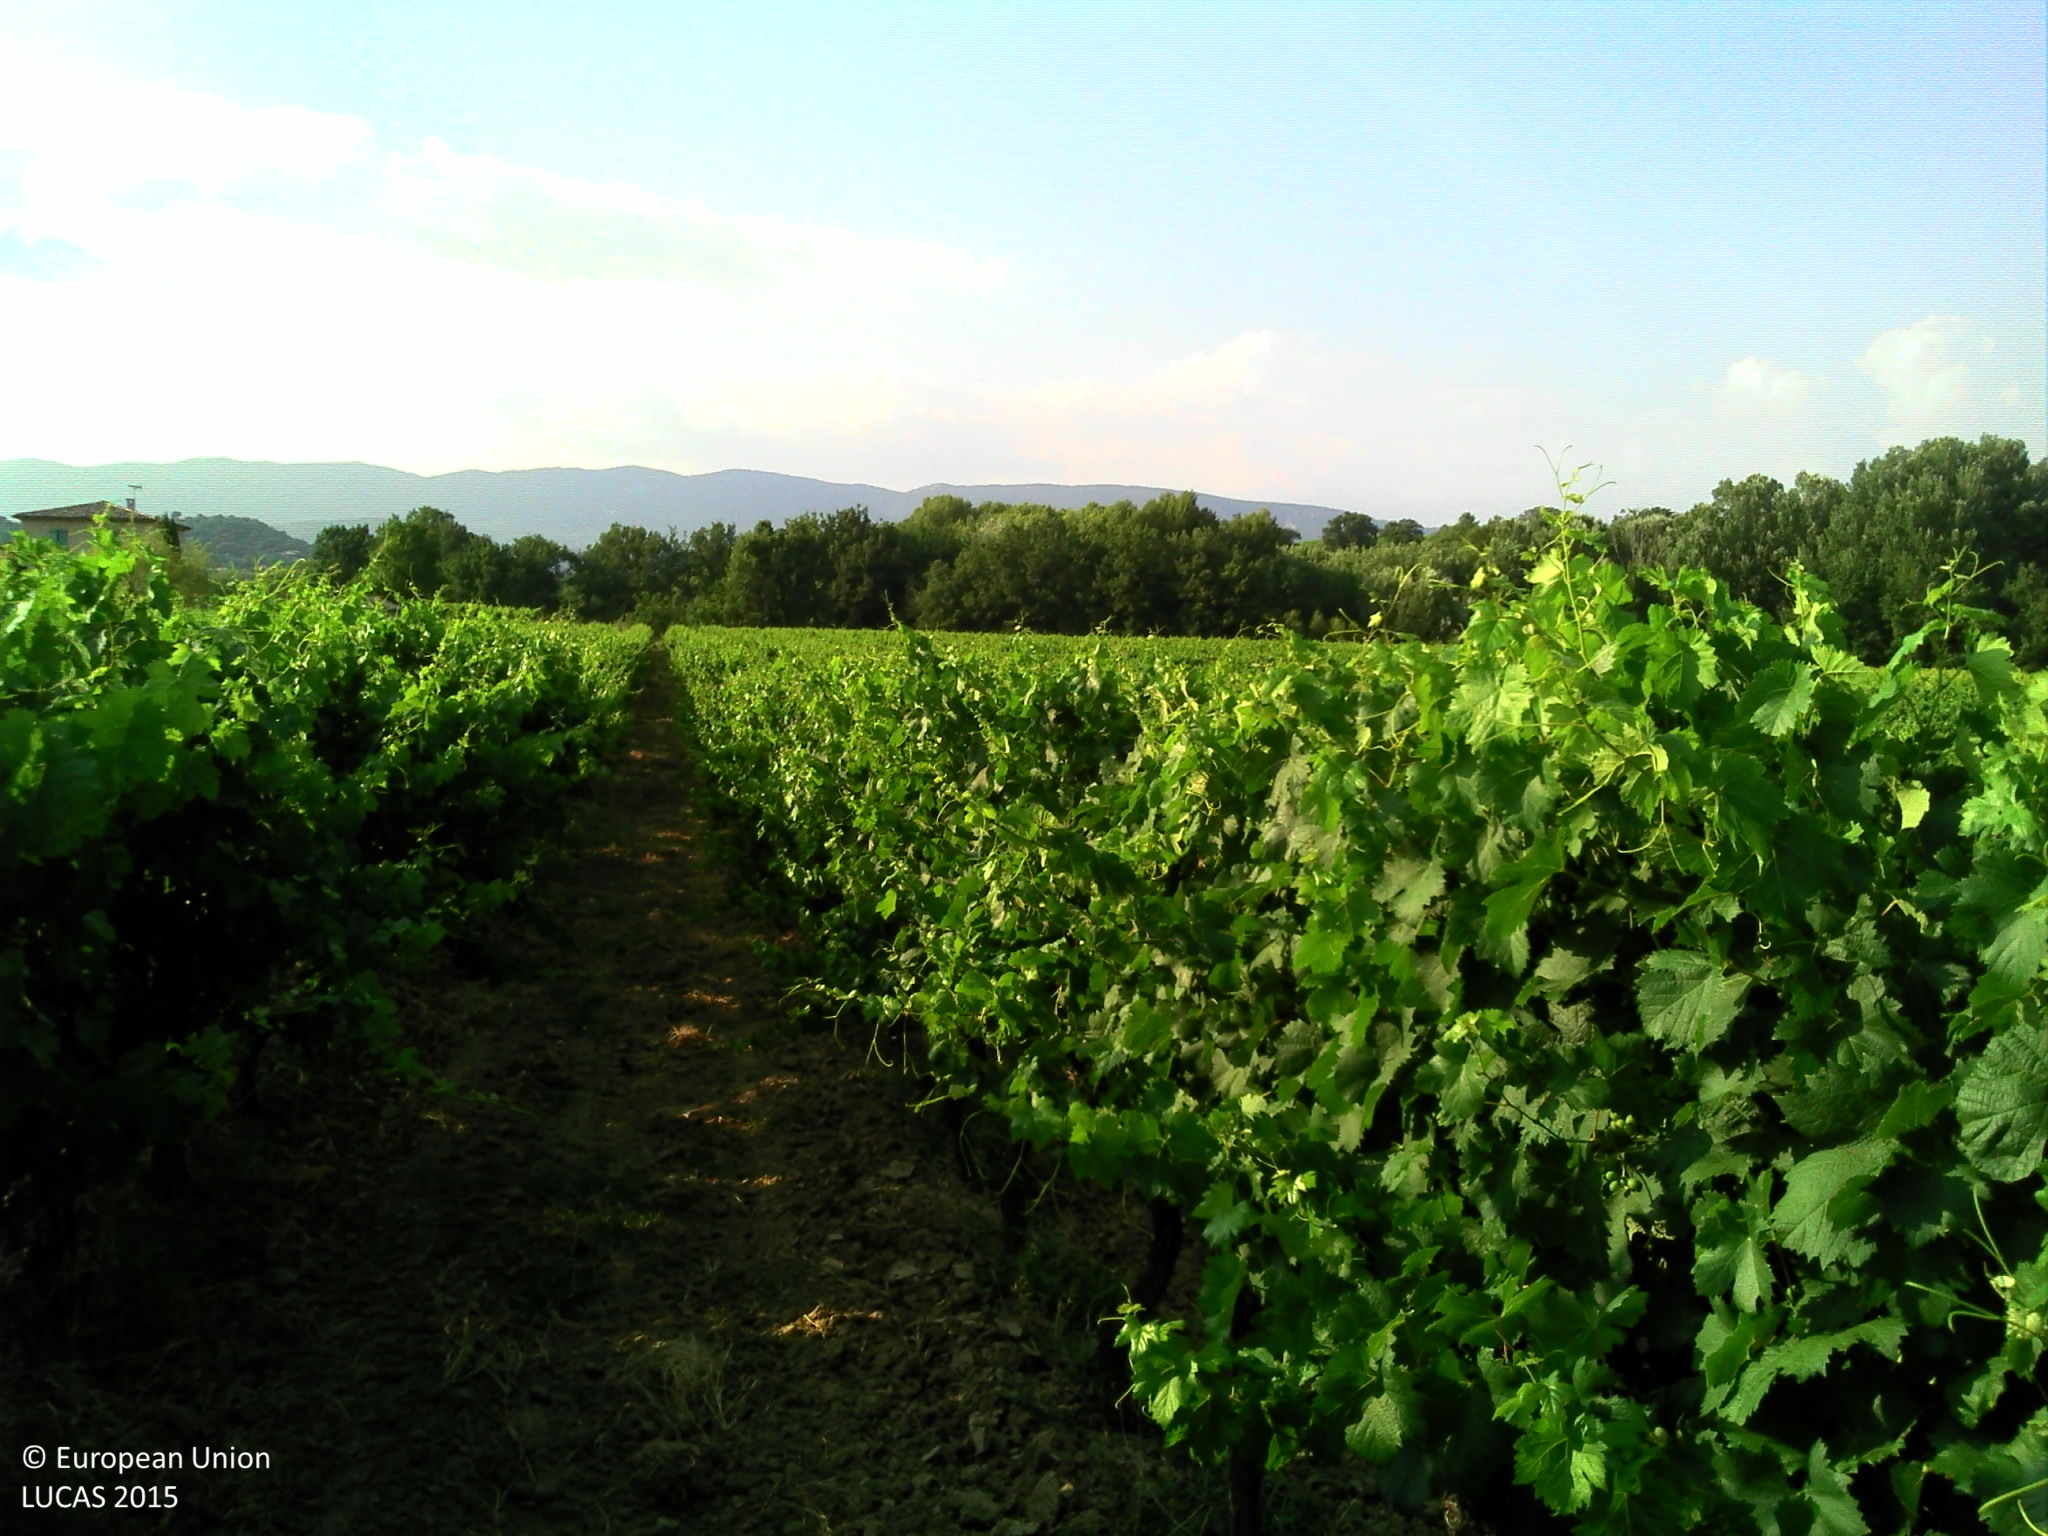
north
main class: Cropland
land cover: Vineyards
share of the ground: 25 - 50 %
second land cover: Other bare soil
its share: > 75 %
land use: Agriculture (excluding fallow land and kitchen gardens)
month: July
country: FR
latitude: 43.7493
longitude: 5.5506
